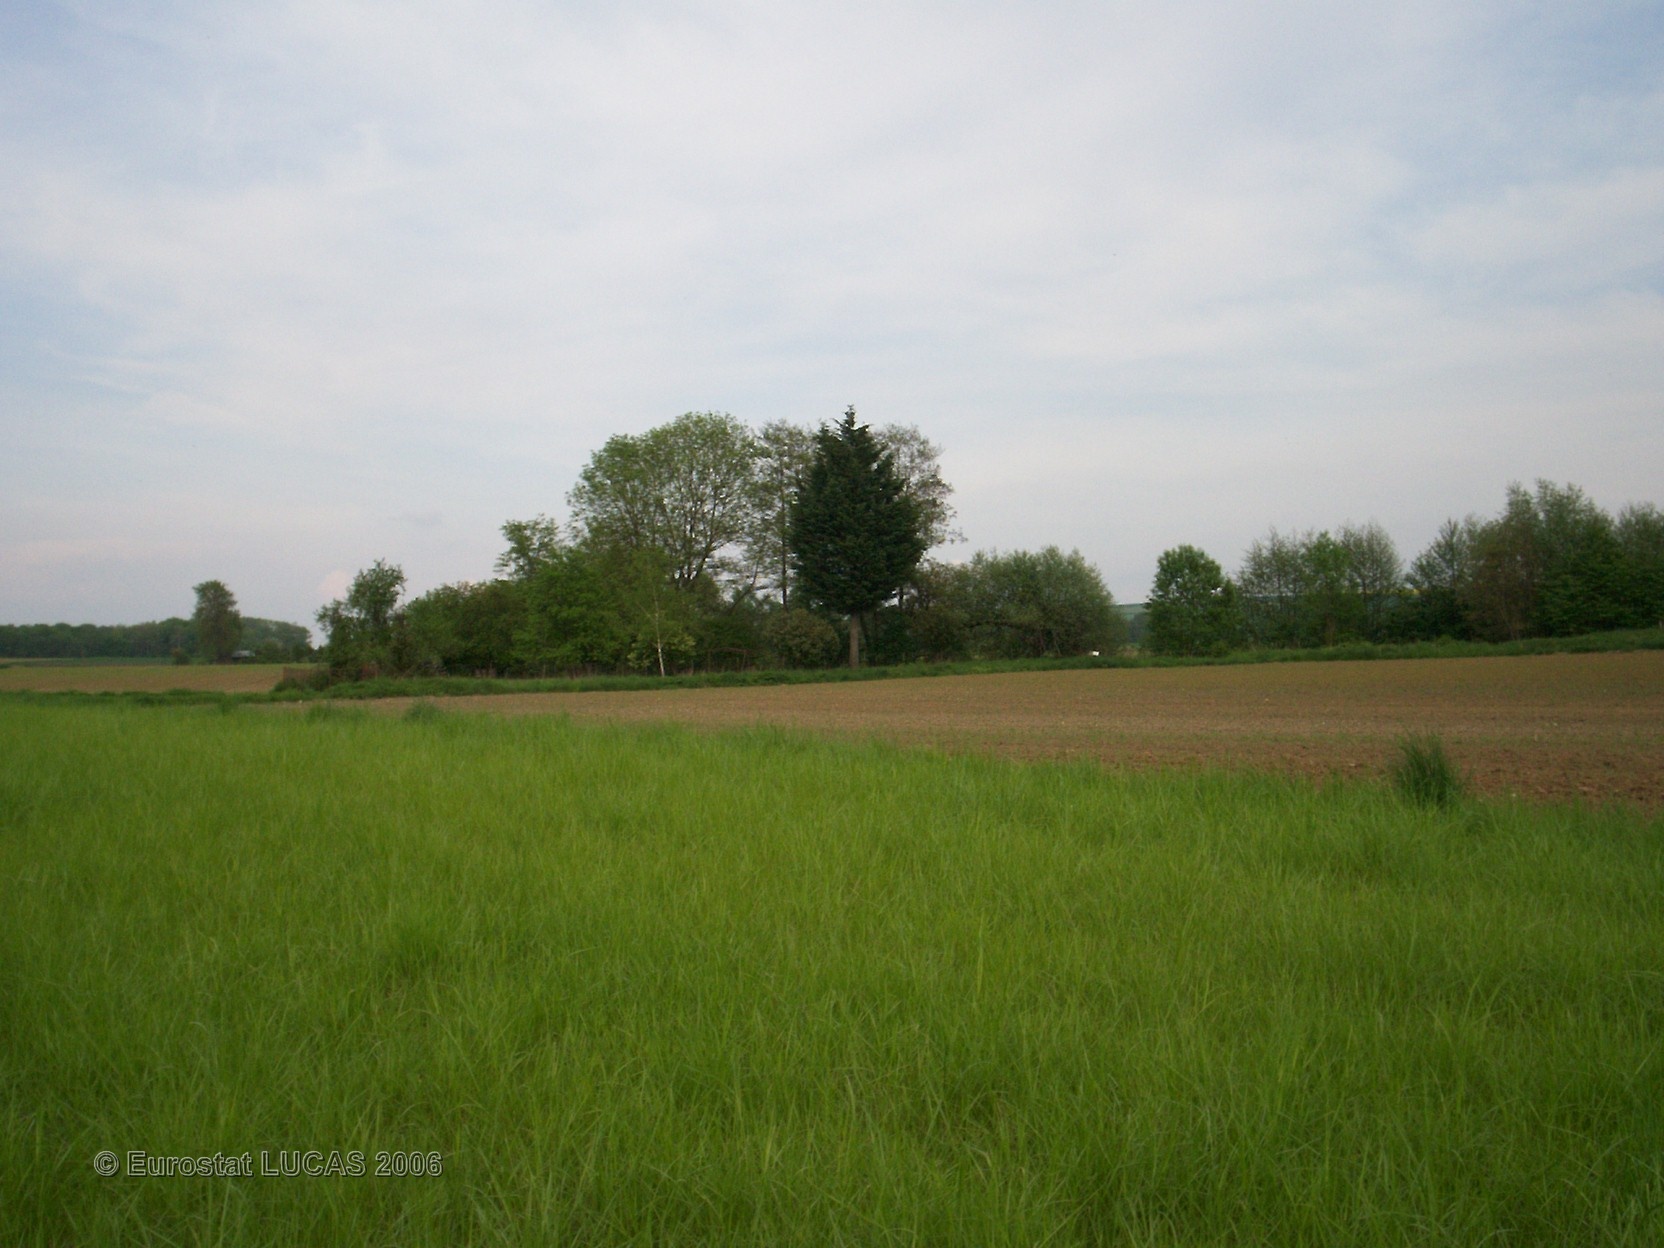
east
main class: Grassland
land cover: Grassland without tree/shrub cover
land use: Agriculture (excluding fallow land and kitchen gardens)
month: May
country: FR
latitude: 49.5556
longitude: 4.3141
